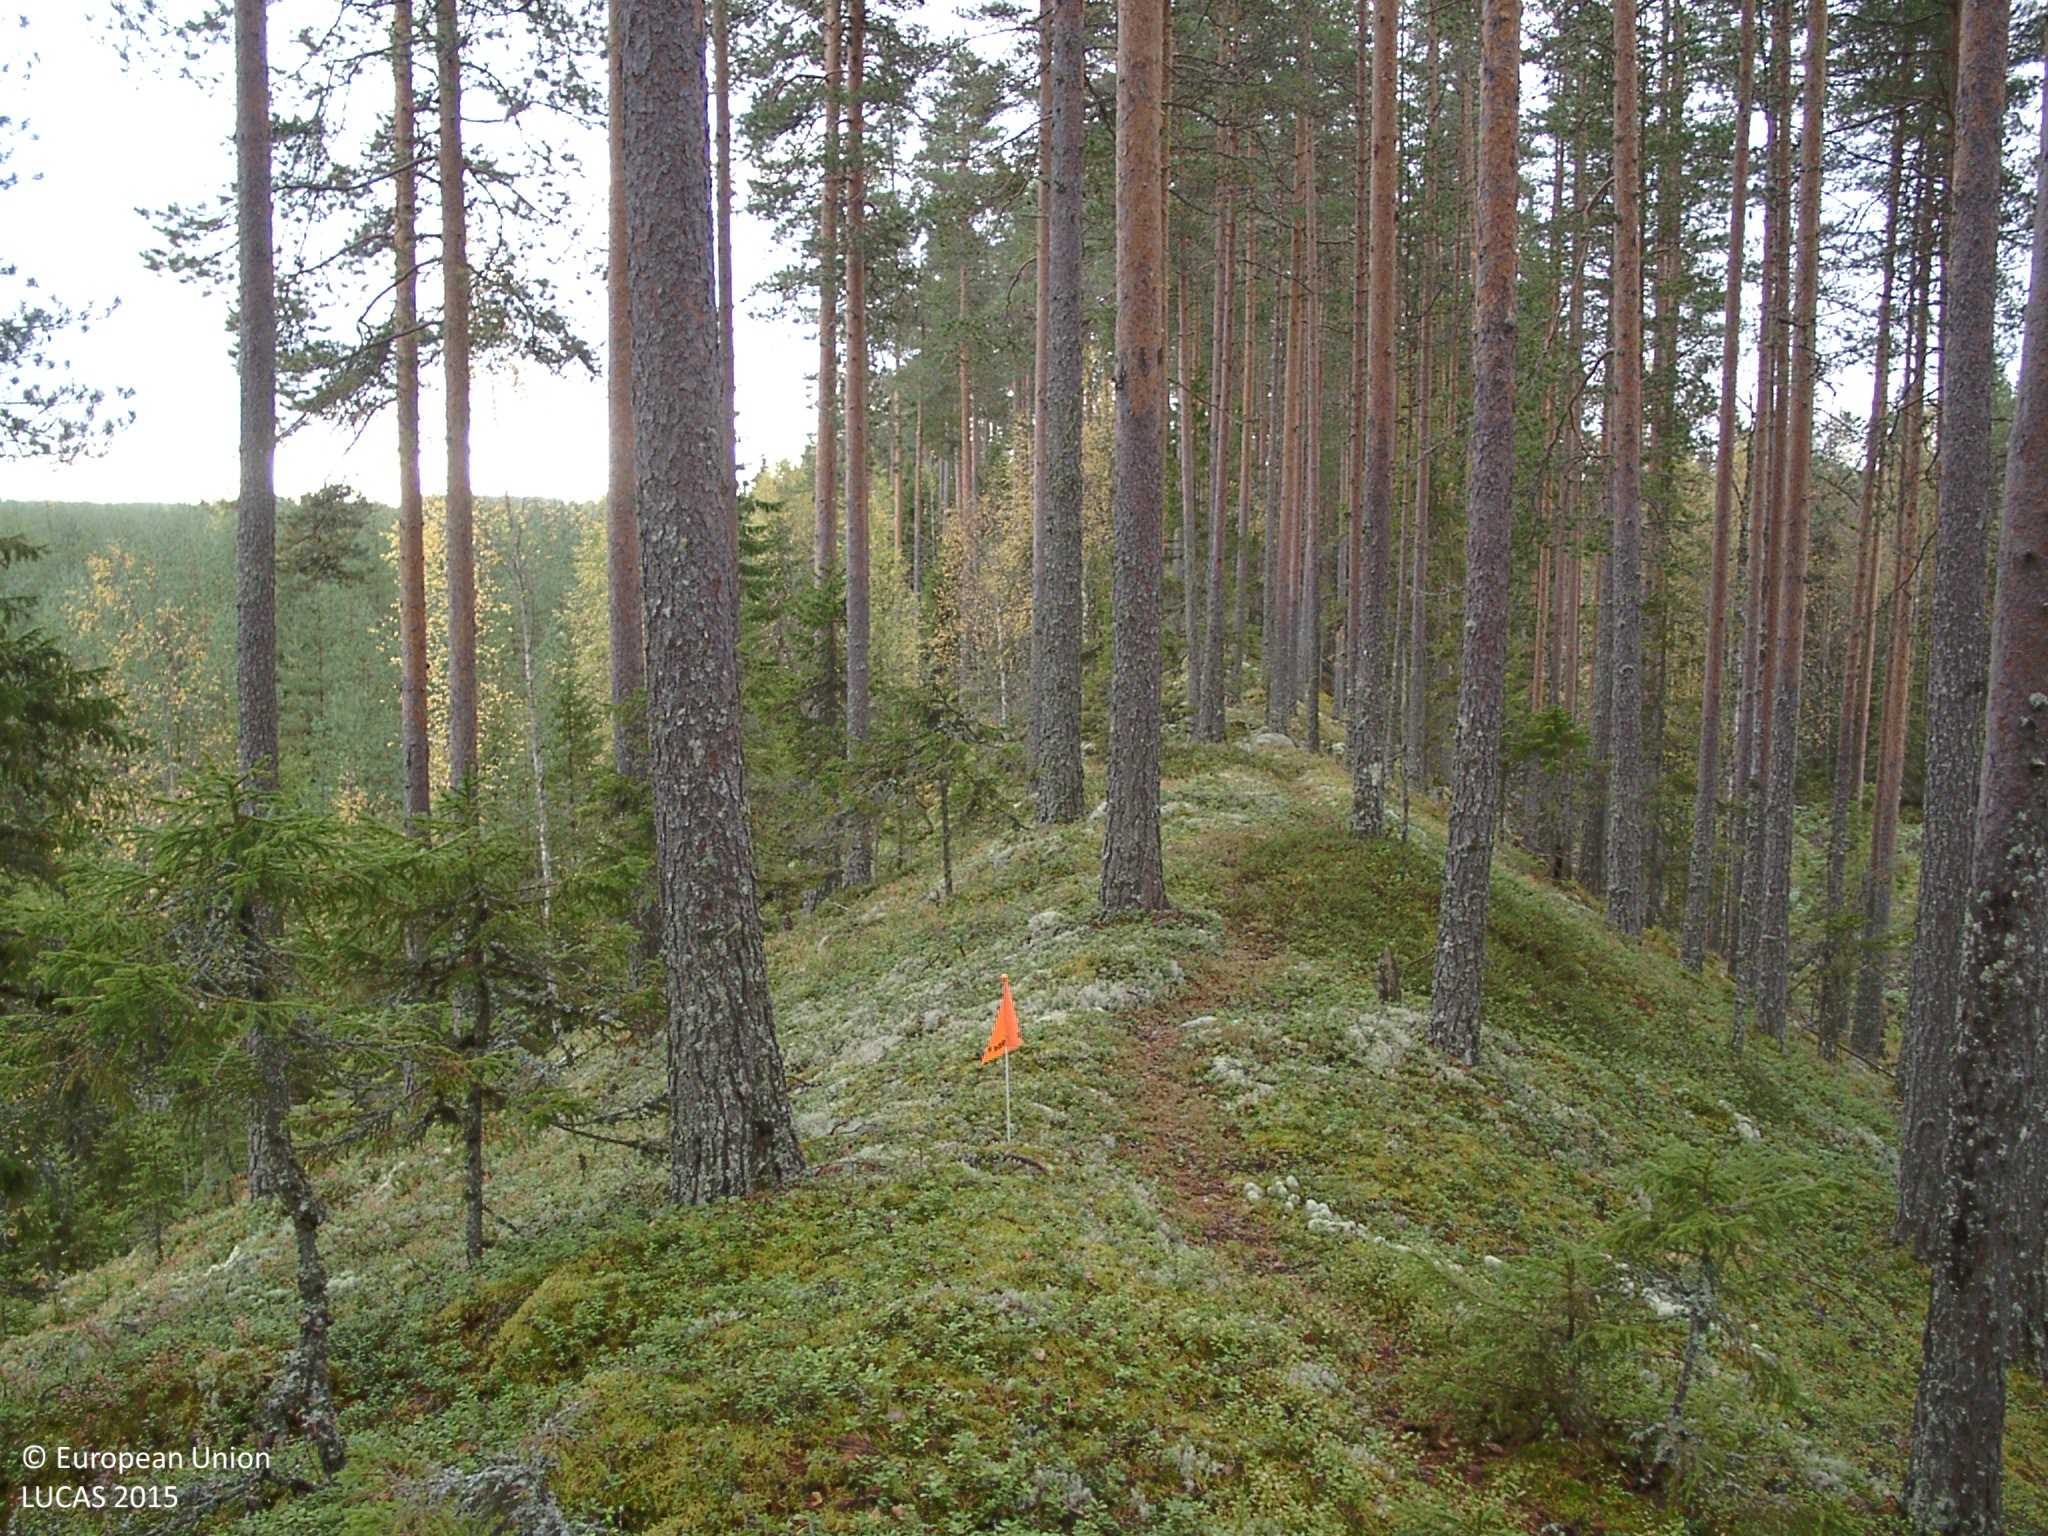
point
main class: Woodland
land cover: Pine dominated coniferous woodland
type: boreal forest
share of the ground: 50 - 75 %
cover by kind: coniferous forest trees 60 %, lichens and mosses 25 %, shrubs 15 %
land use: Forestry
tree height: > 5 m
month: September
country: FI
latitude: 62.7791
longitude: 25.3310
